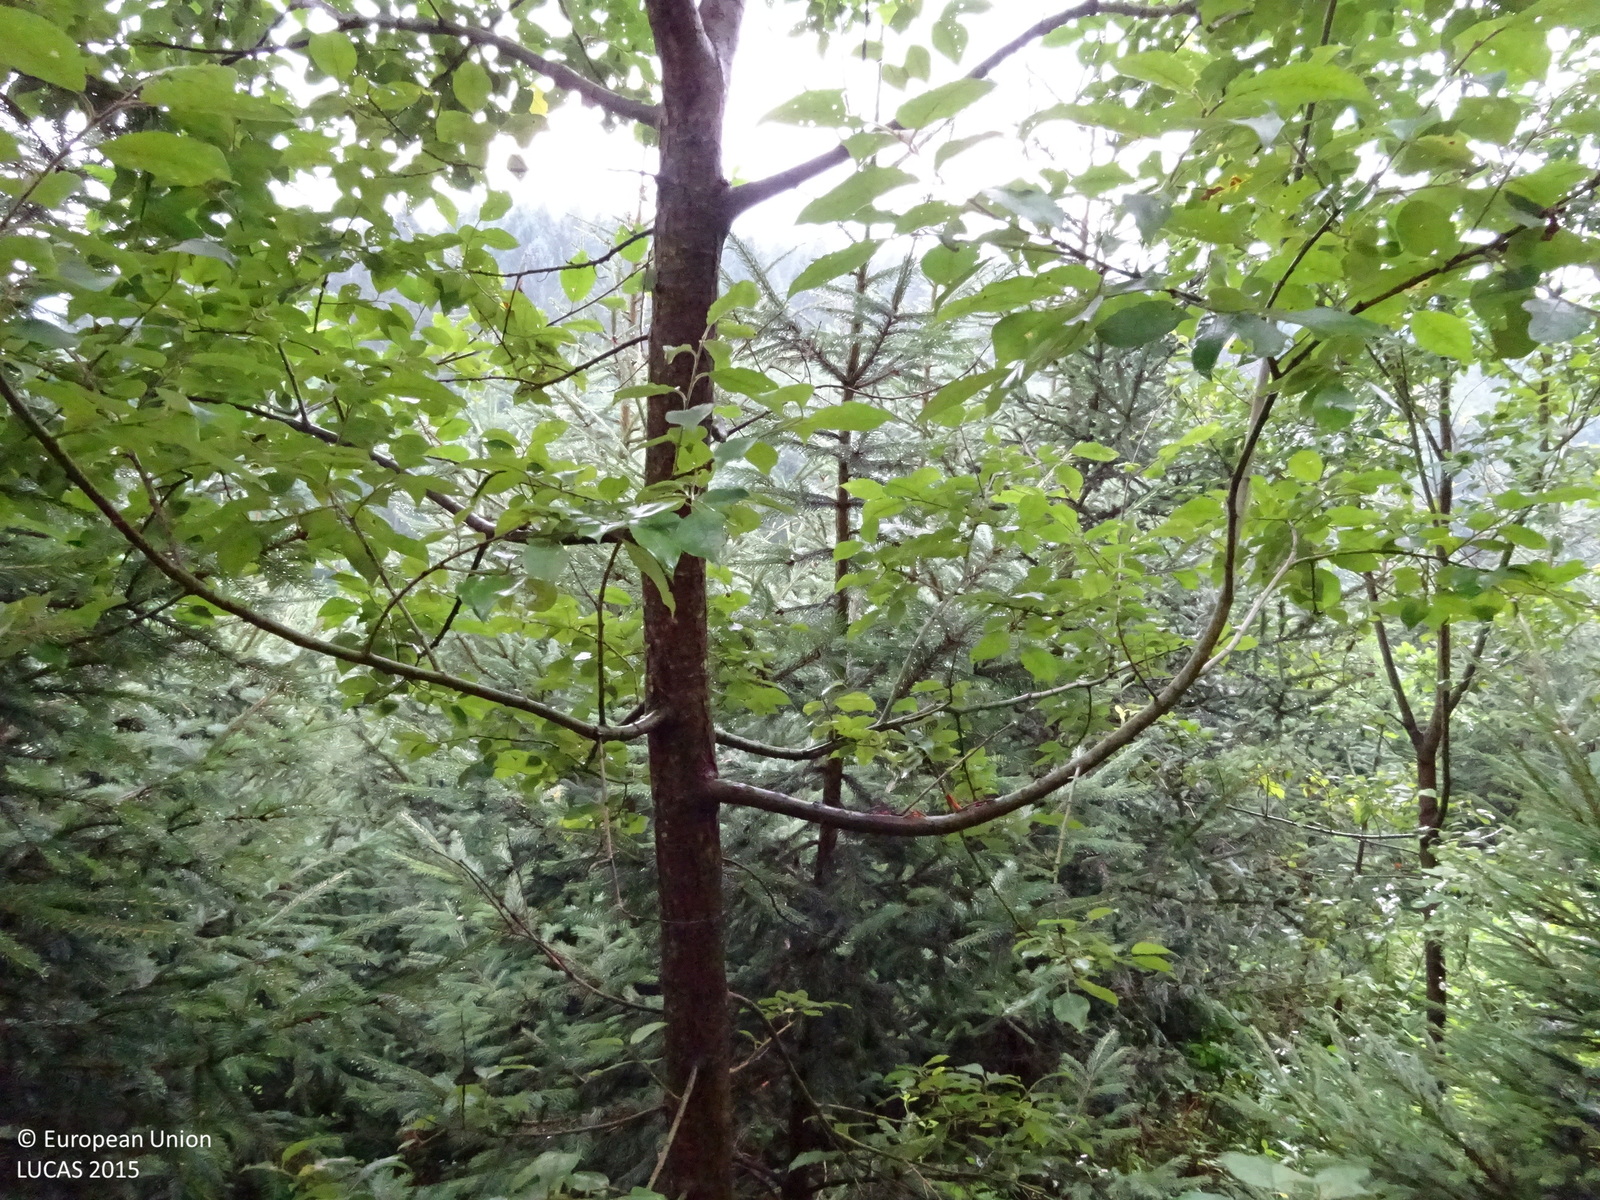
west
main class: Woodland
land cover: Spruce dominated coniferous woodland
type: alpine coniferous forest
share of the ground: 50 - 75 %
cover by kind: coniferous forest trees 60 %, herbaceous plants 20 %, broadleaved forest trees 10 %, shrubs 10 %
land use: Forestry
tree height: > 5 m
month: July
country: AT
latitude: 46.7984
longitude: 15.2791
